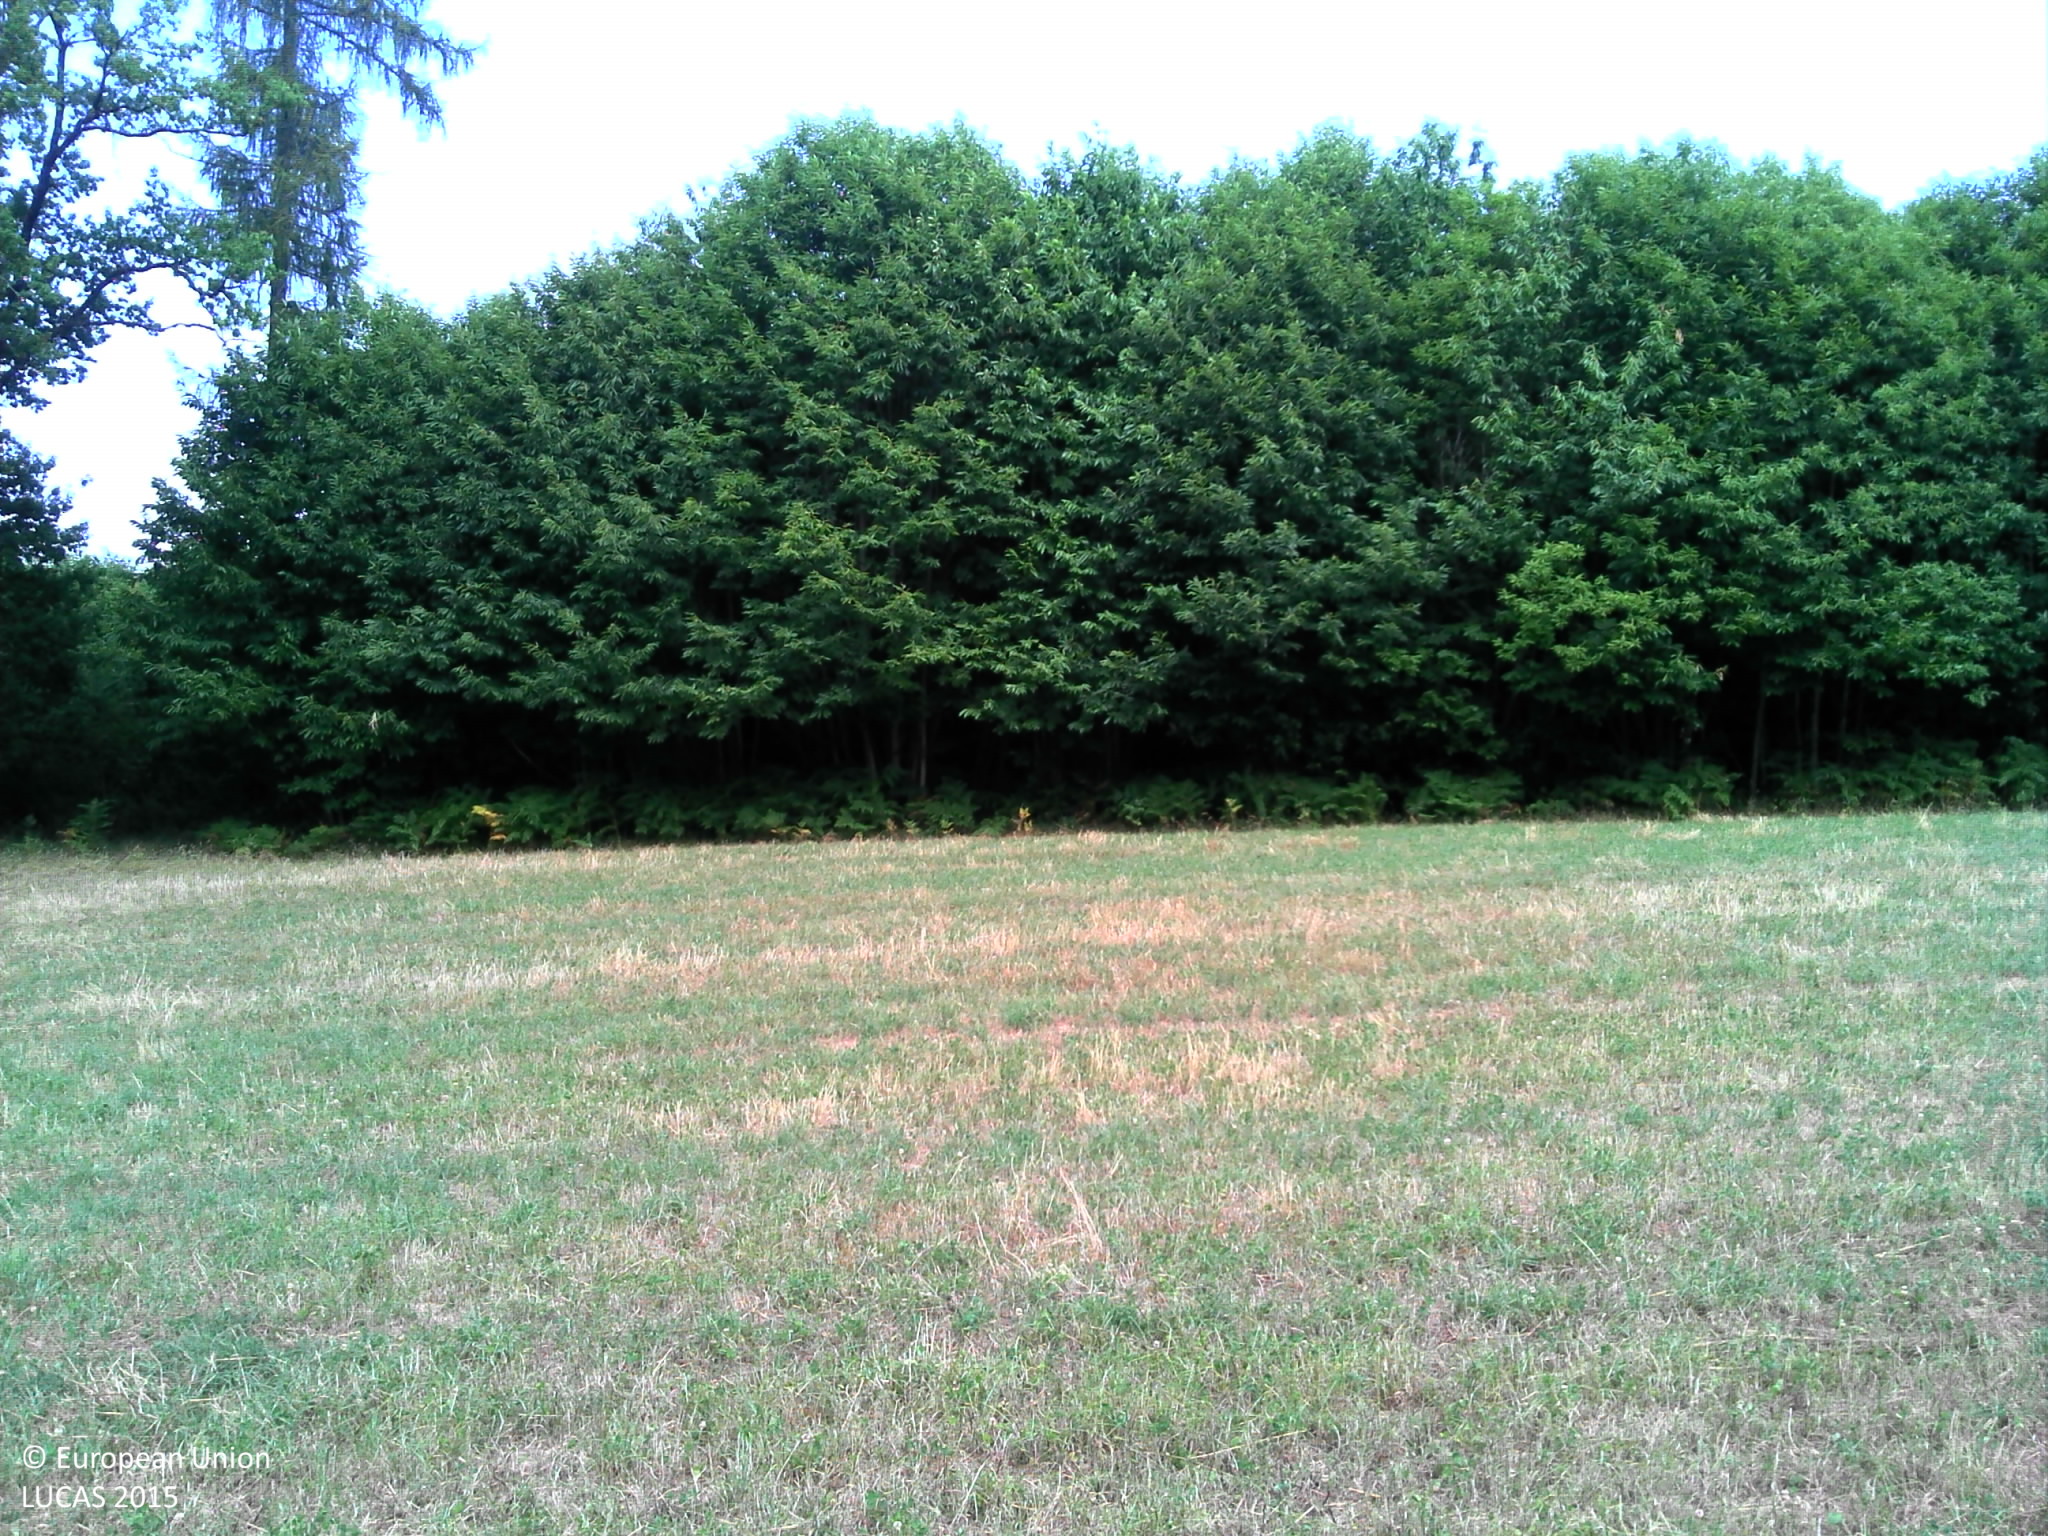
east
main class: Grassland
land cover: Grassland without tree/shrub cover
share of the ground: > 75 %
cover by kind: herbaceous plants 100 %
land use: Agriculture (excluding fallow land and kitchen gardens)
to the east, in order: Grassland without tree/shrub cover; Broadleaved woodland; Shrubland with sparse tree cover; Broadleaved woodland; Spontaneously vegetated surfaces; Electric lines; Spontaneously vegetated surfaces; Broadleaved woodland
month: July
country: FR
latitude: 45.6647
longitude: 1.0182
